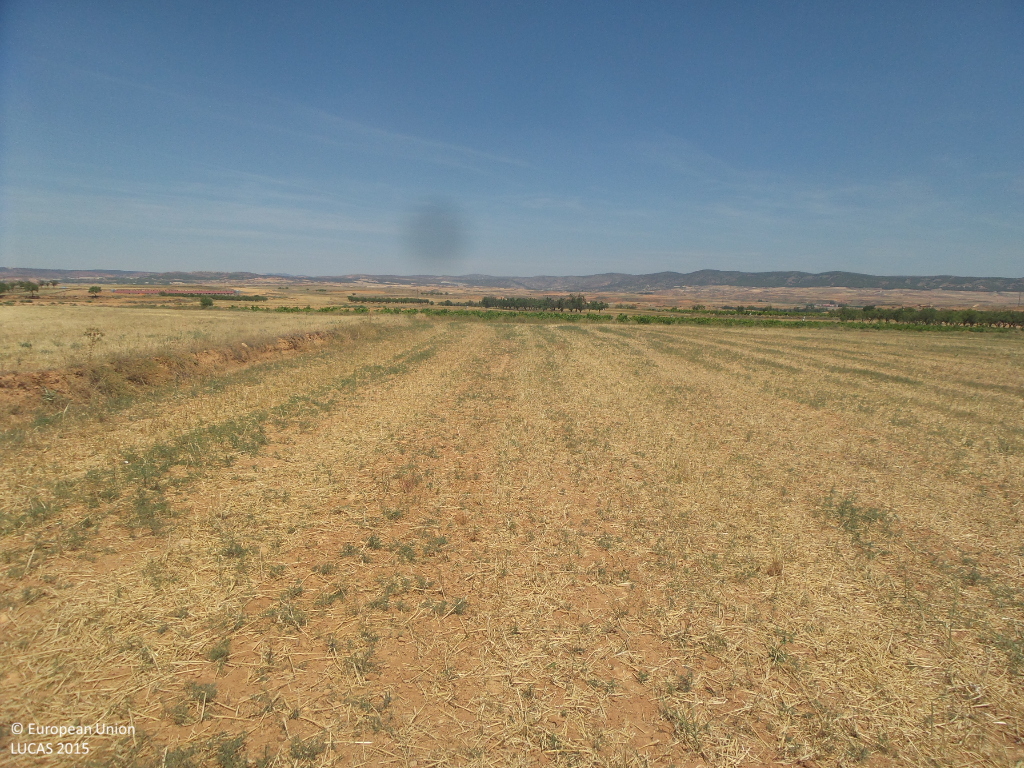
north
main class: Cropland
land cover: Barley
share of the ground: < 10 %
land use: Agriculture (excluding fallow land and kitchen gardens)
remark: Harvested field
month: July
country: ES
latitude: 41.2835
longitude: -1.9795
